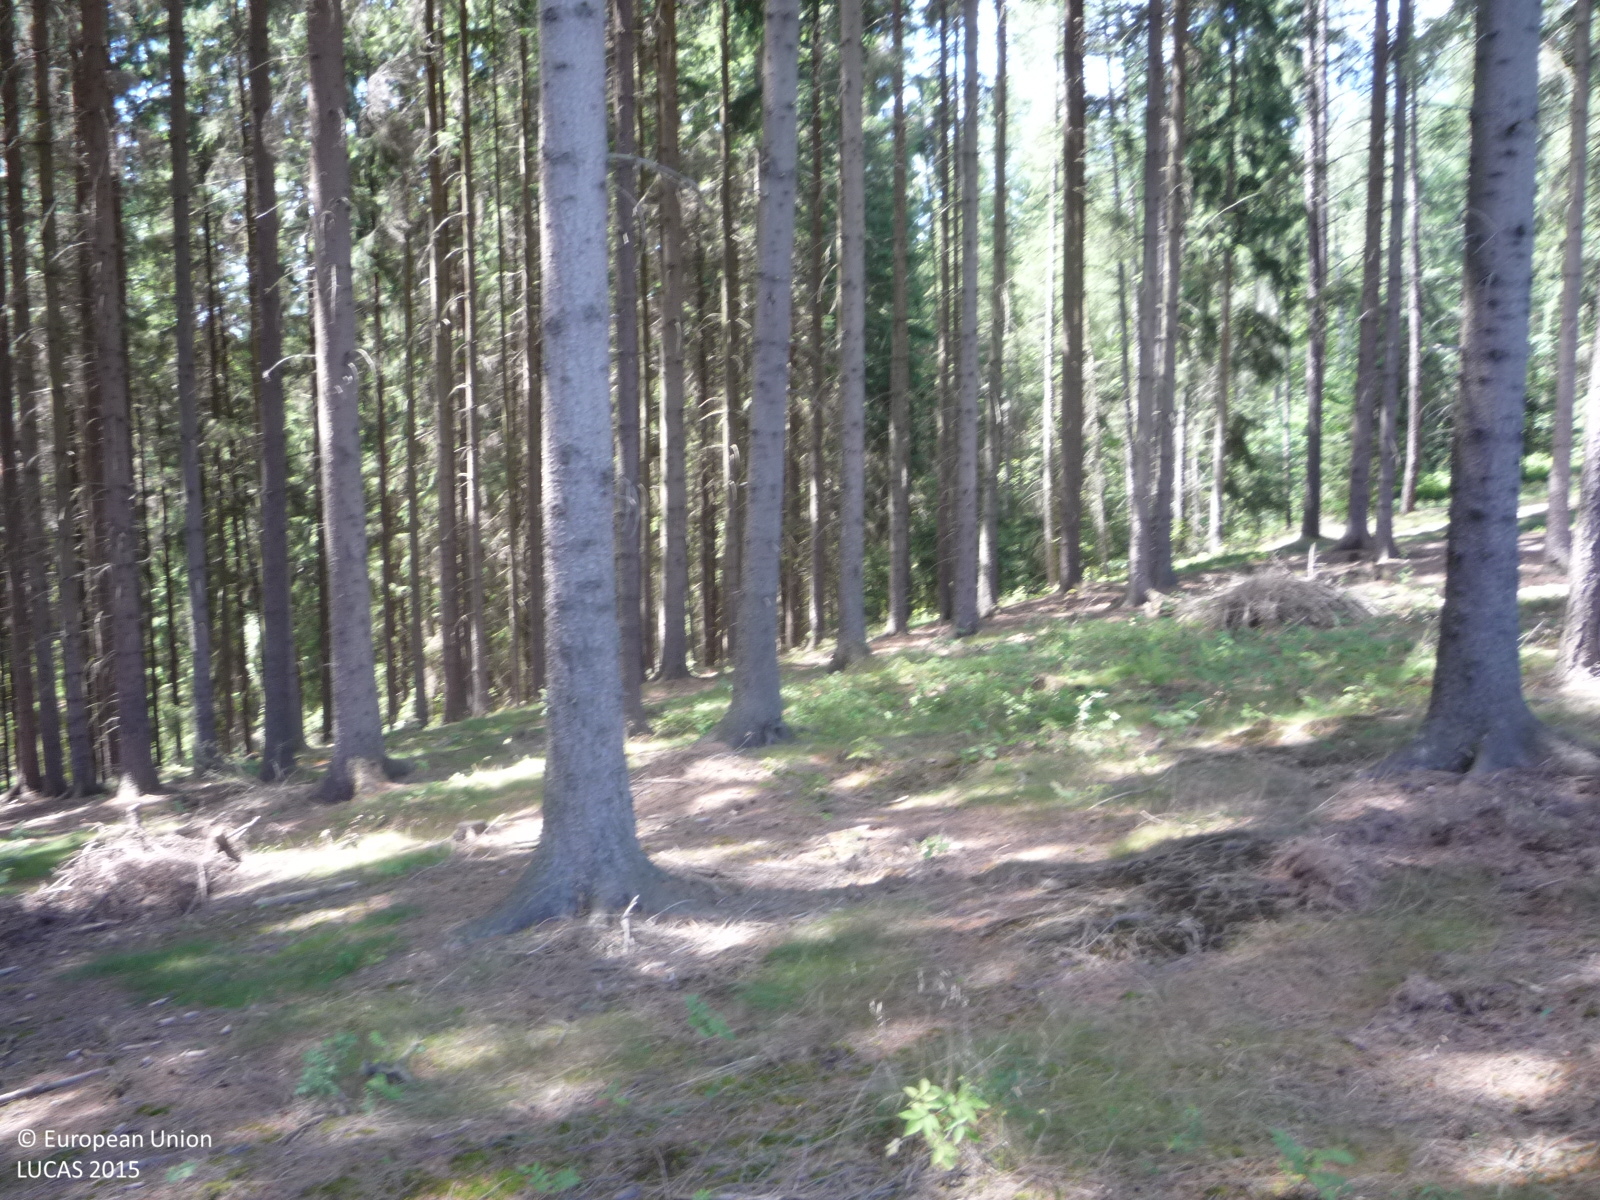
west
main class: Woodland
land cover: Spruce dominated coniferous woodland
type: hemiboreal forest and nemoral coniferous forest and mixed broadleaved-coniferous forest
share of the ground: > 75 %
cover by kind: coniferous forest trees 85 %, unconsolidated bare surface 10 %, herbaceous plants 5 %
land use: Forestry
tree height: > 5 m
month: July
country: CZ
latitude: 50.5440
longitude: 15.7483
